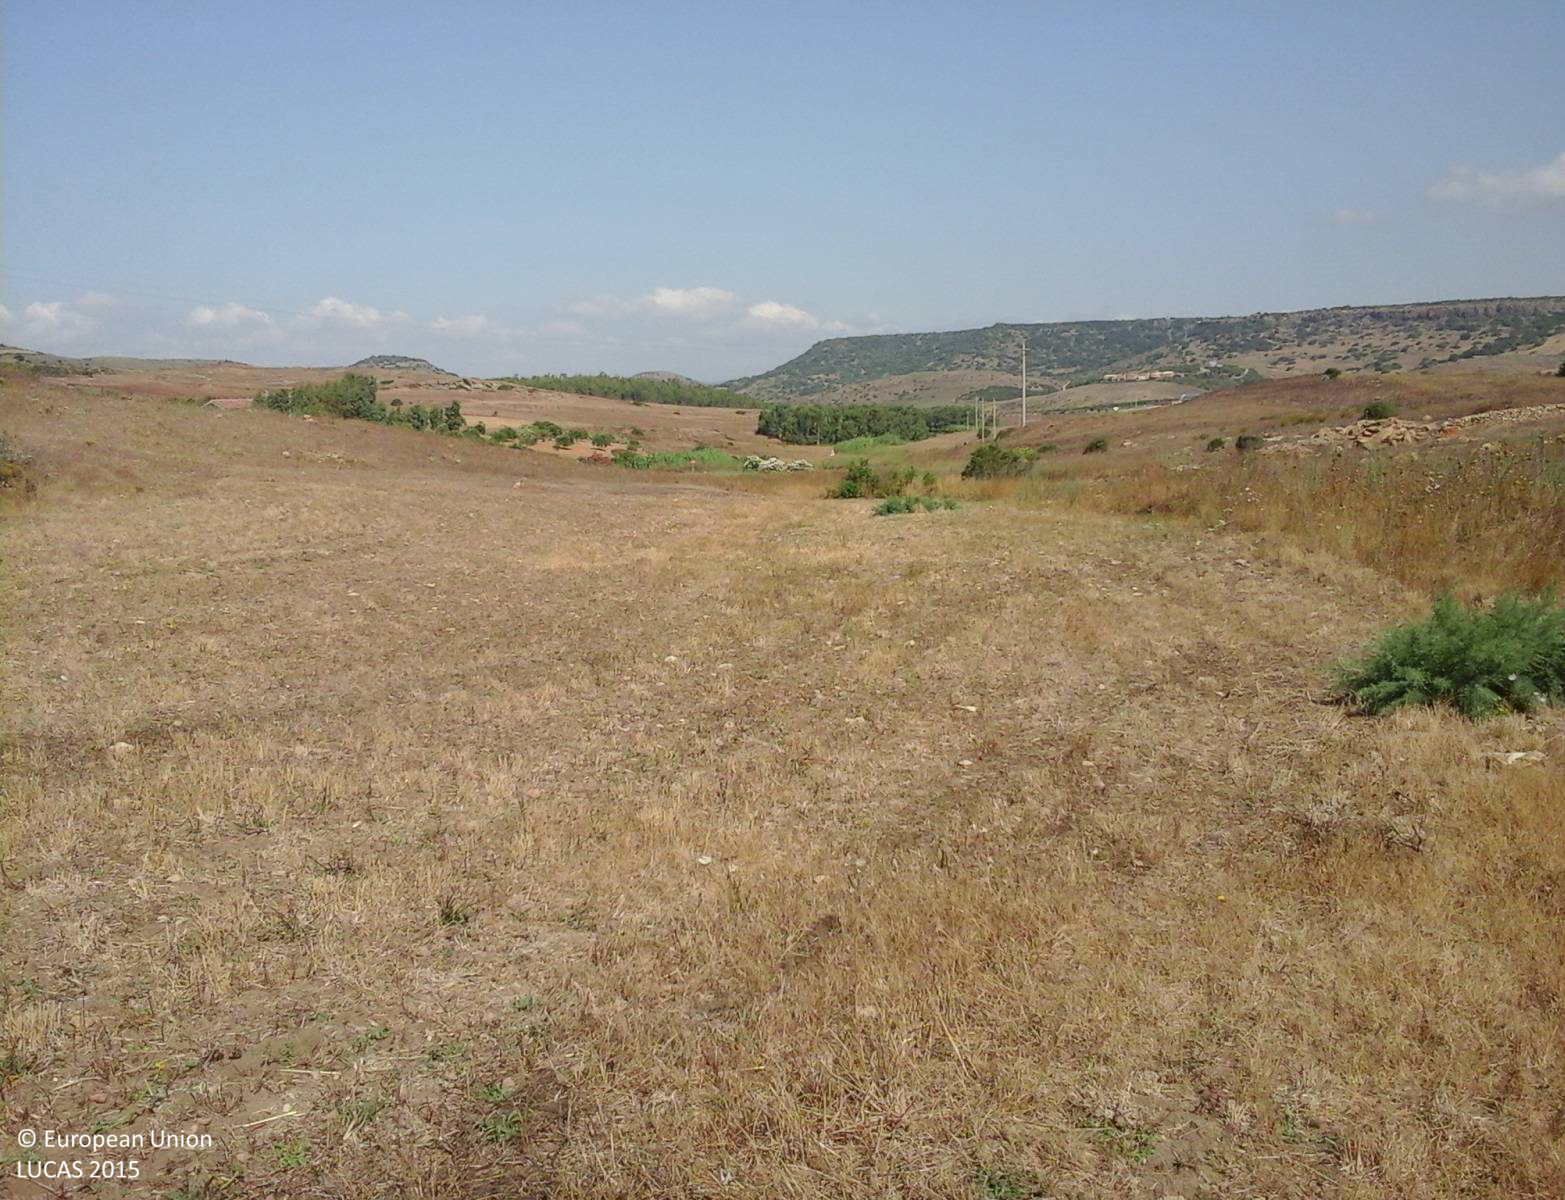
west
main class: Grassland
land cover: Spontaneously vegetated surfaces
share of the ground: > 75 %
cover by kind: herbaceous plants 100 %
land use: Agriculture (excluding fallow land and kitchen gardens)
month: July
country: IT
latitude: 39.6452
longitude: 8.8762
